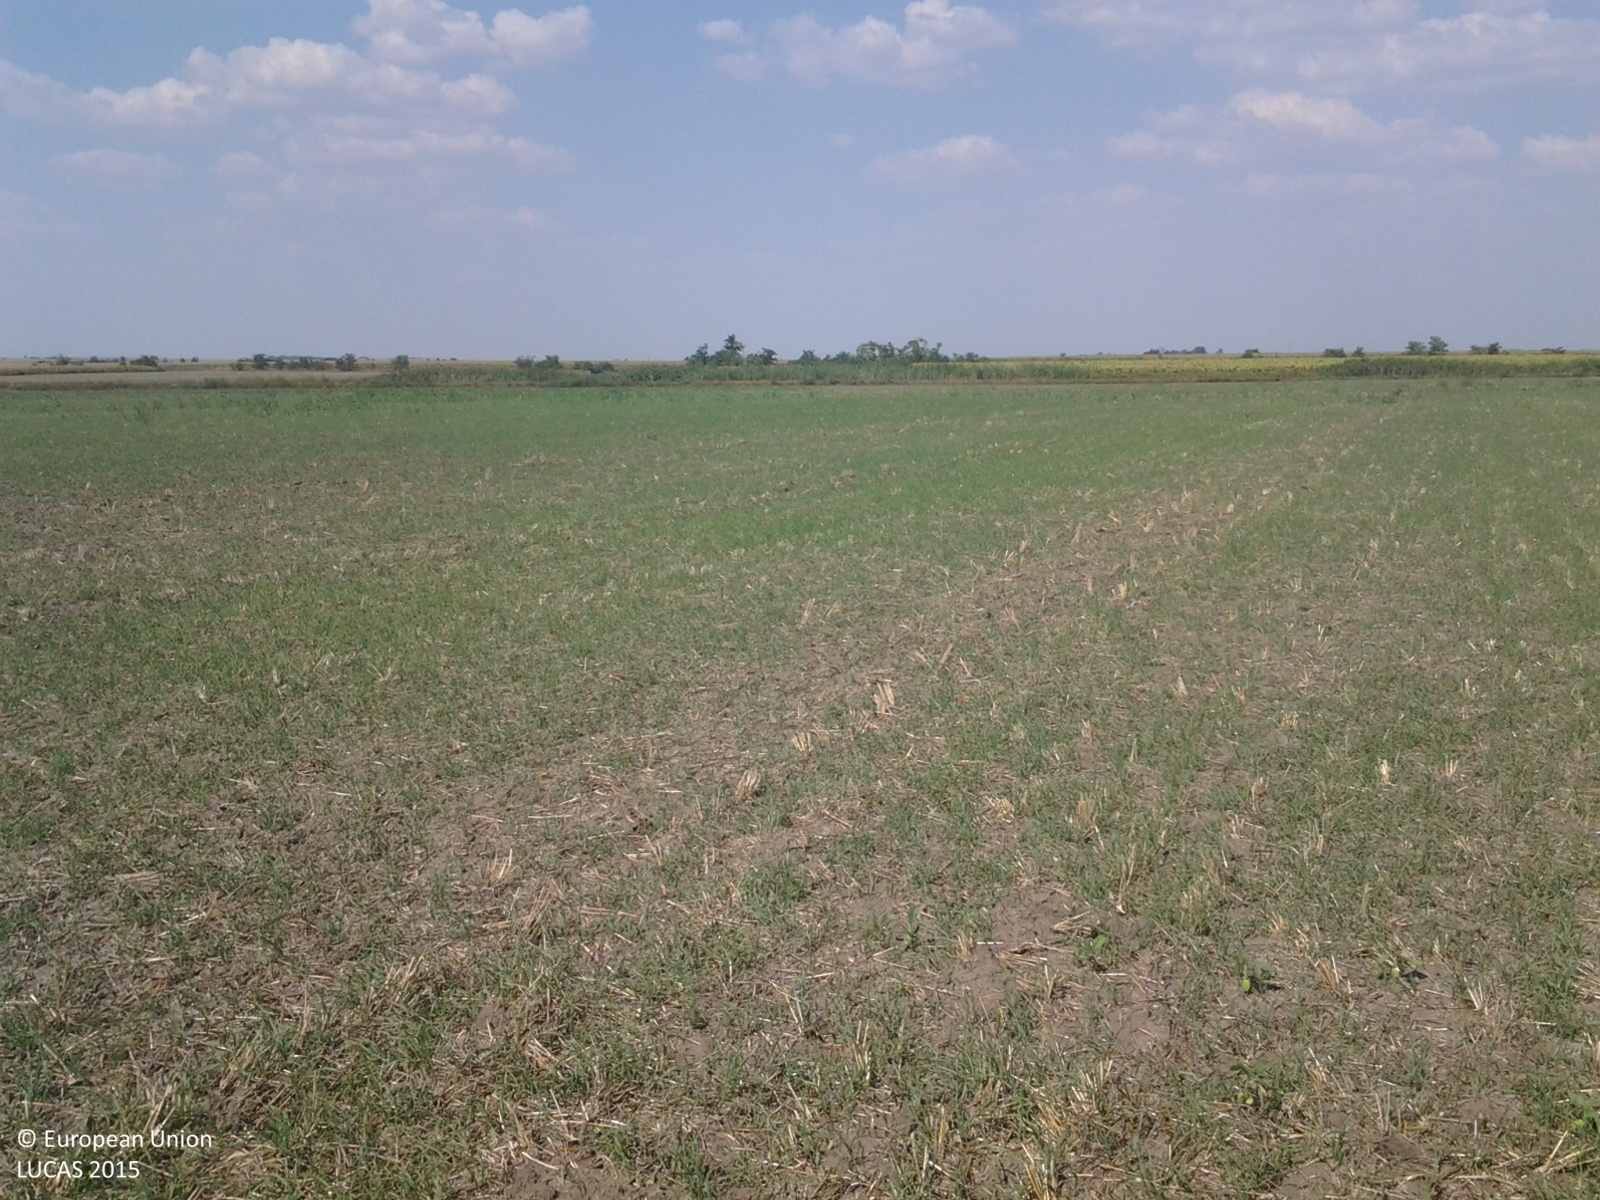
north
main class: Cropland
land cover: Common wheat
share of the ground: 10 - 25 %
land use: Agriculture (excluding fallow land and kitchen gardens)
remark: Harvested field
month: August
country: HU
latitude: 47.2861
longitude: 19.7140
